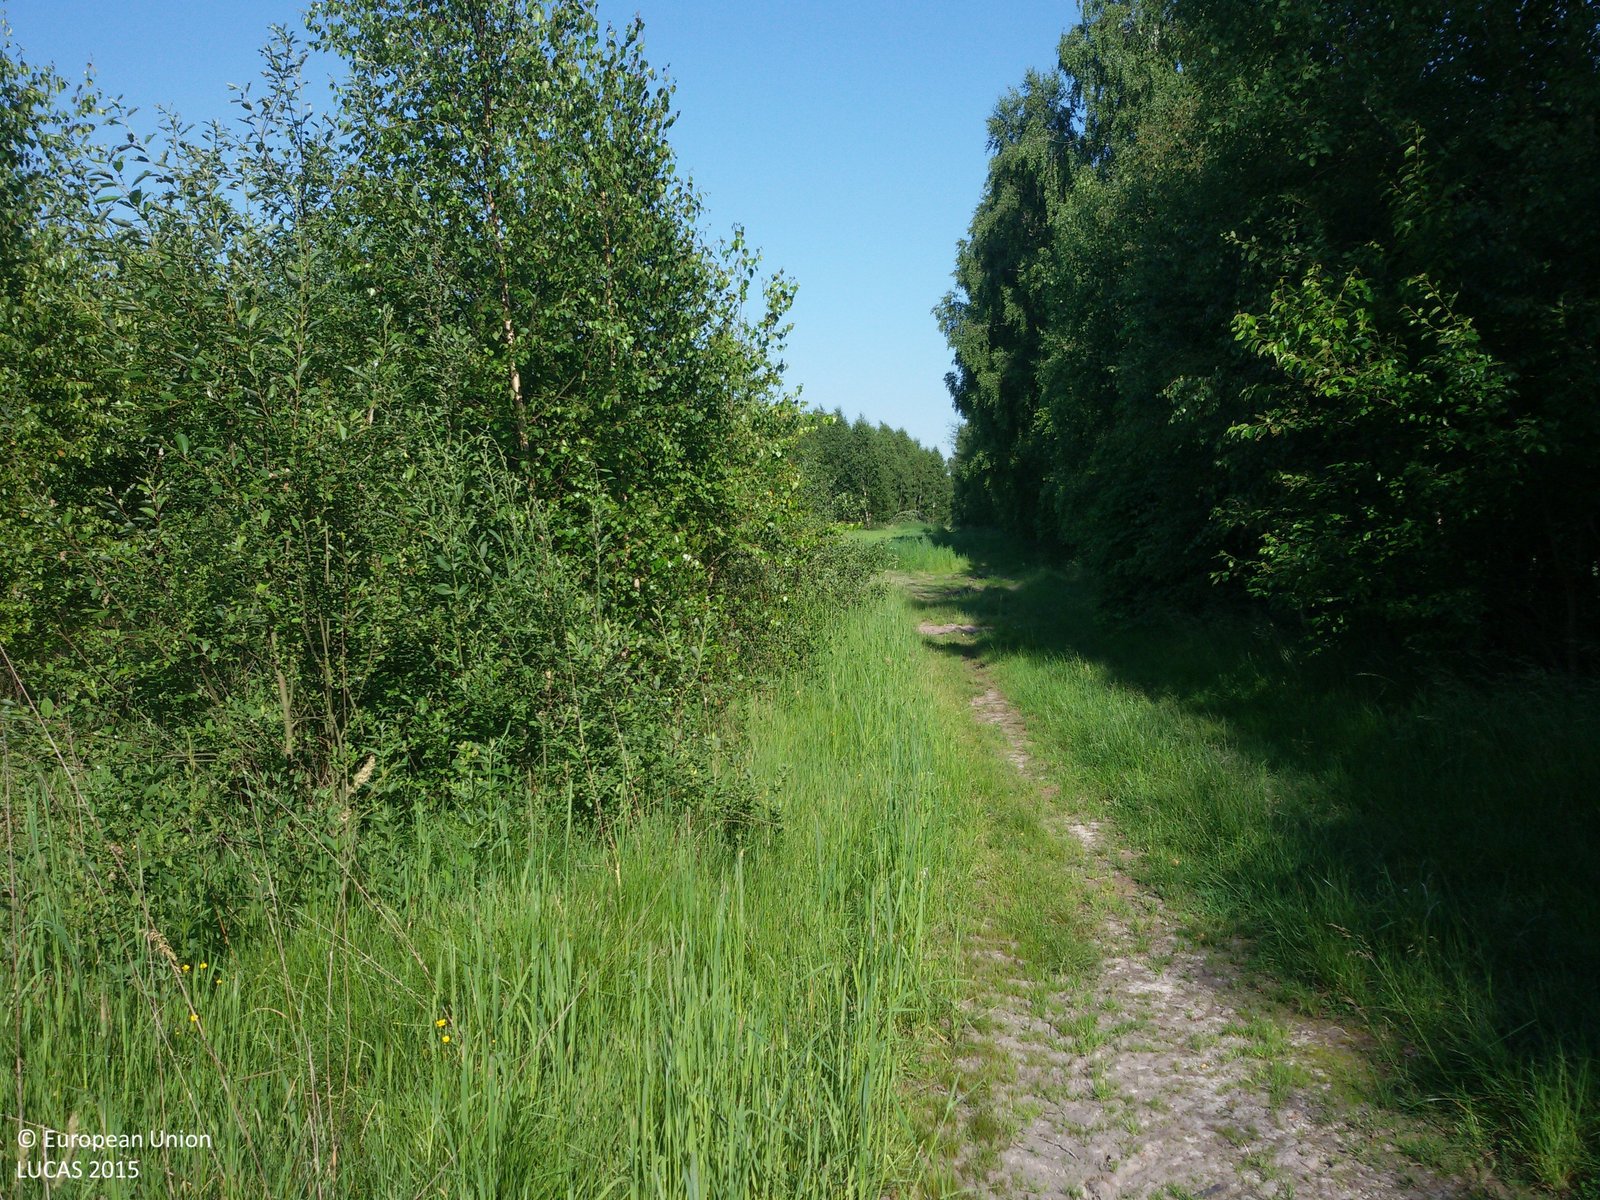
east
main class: Woodland
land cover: Broadleaved woodland
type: non-riverine alder, birch or aspen forest
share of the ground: 50 - 75 %
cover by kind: broadleaved forest trees 60 %, herbaceous plants 30 %, shrubs 10 %
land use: Forestry
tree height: < 5 m
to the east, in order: Tracks; Broadleaved woodland; Grassland without tree/shrub cover; Barley; Grassland with sparse tree/shrub cover; Barley; Broadleaved woodland; Barley; Grassland with sparse tree/shrub cover; Rape and turnip rape
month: June
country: PL
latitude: 51.6043
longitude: 22.9976
